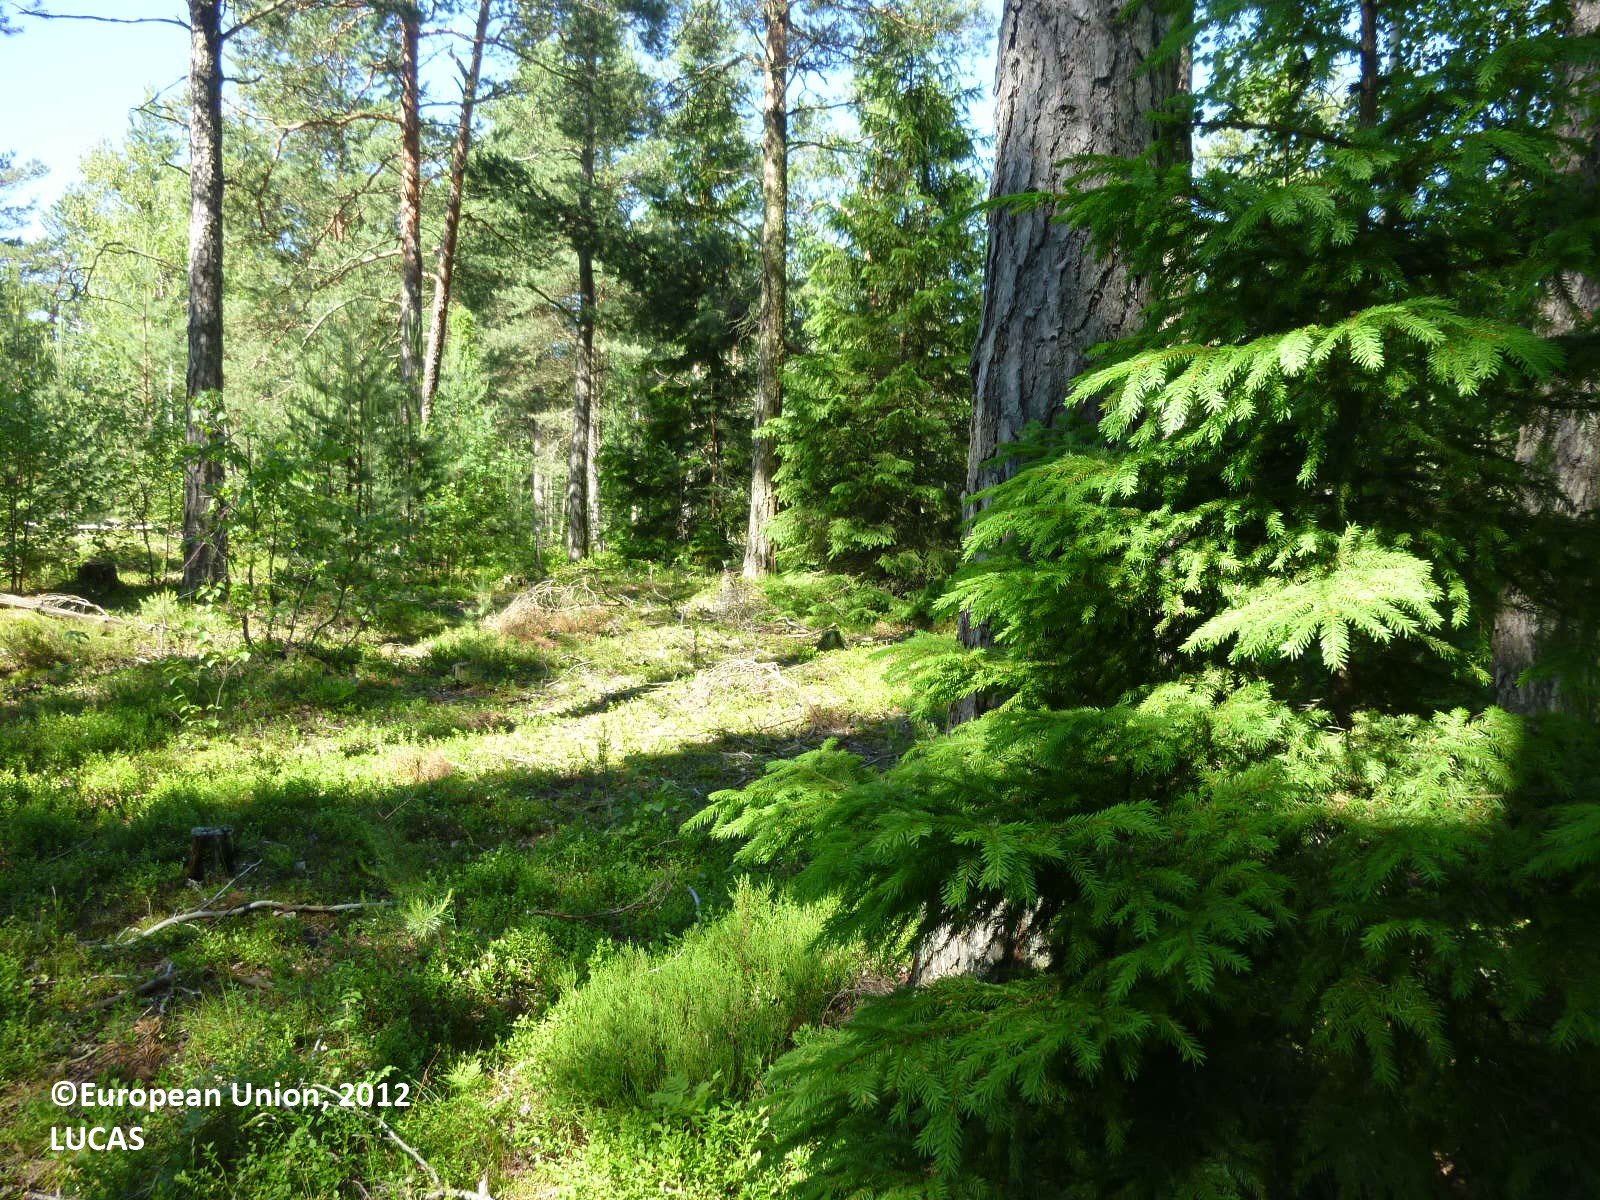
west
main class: Woodland
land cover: Other coniferous woodland
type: boreal forest
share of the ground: 25 - 50 %
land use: Forestry
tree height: > 5 m
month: June
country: FI
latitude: 60.2091
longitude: 22.4679
